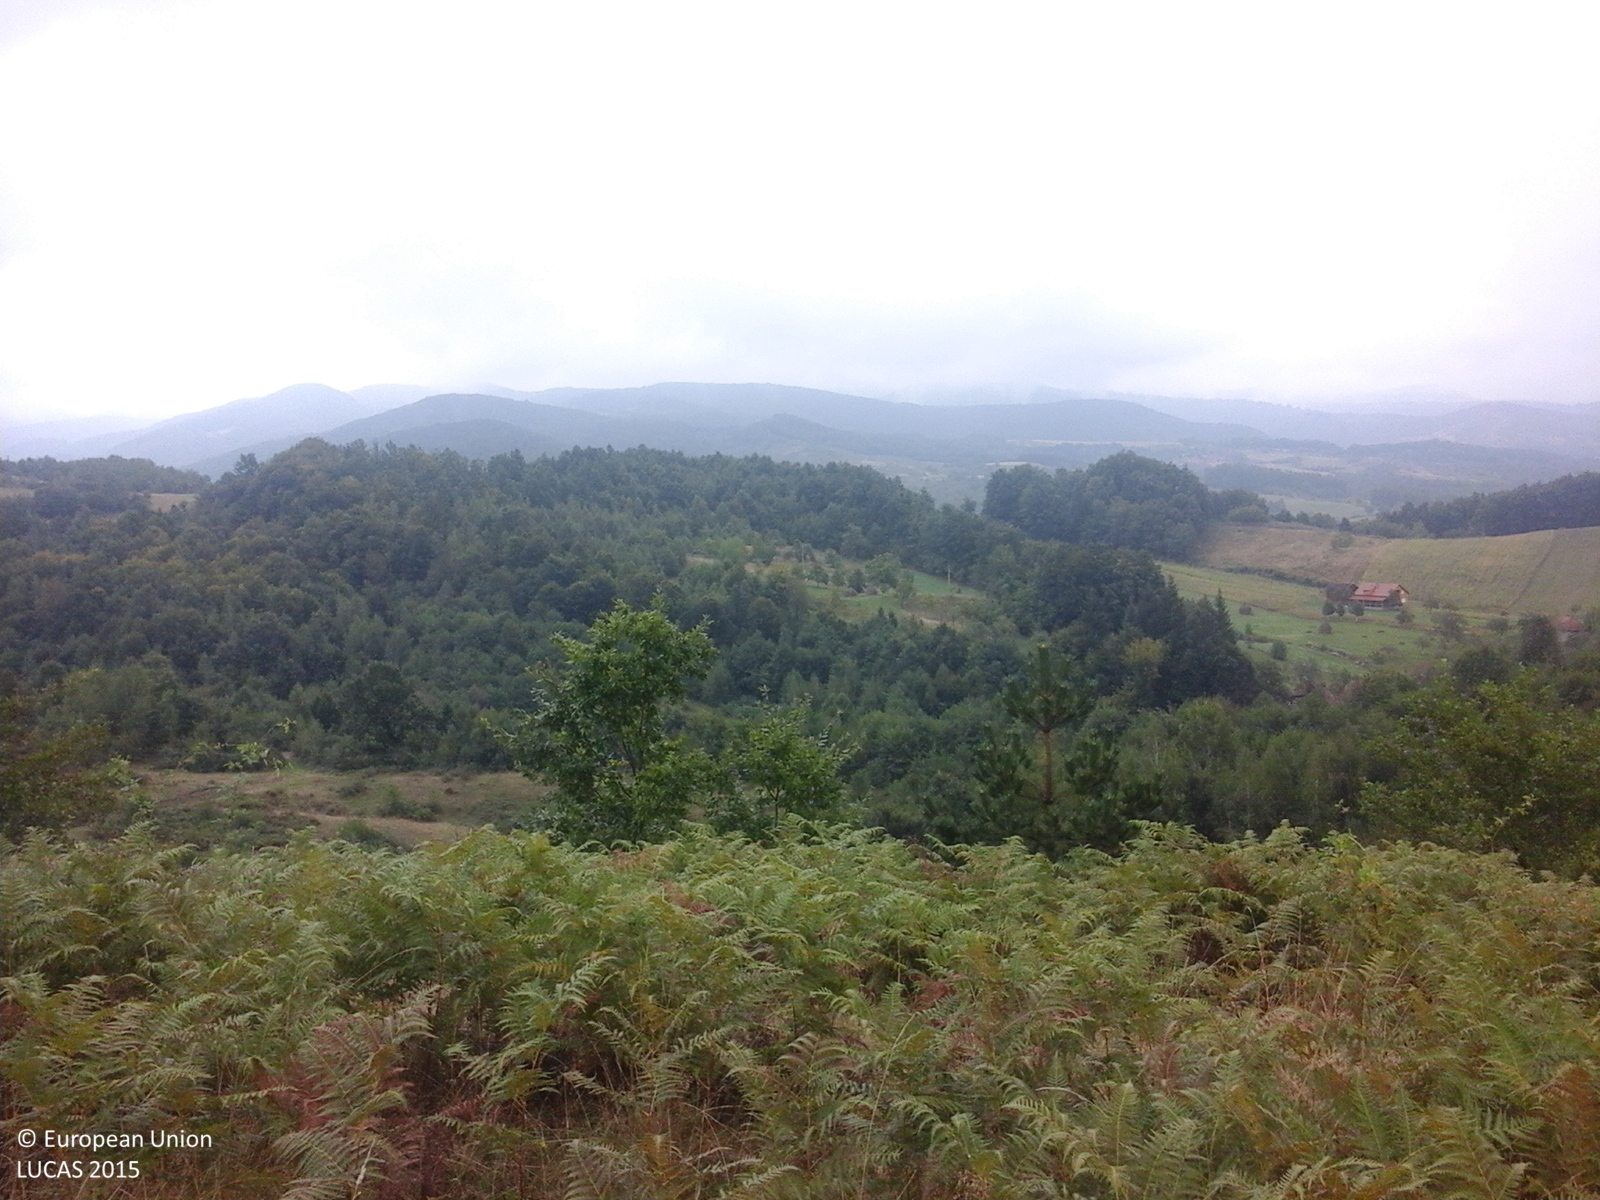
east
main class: Grassland
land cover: Spontaneously vegetated surfaces
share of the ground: > 75 %
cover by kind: herbaceous plants 100 %
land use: Fallow land
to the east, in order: Spontaneously vegetated surfaces; Grassland with sparse tree/shrub cover; Broadleaved woodland; Grassland with sparse tree/shrub cover; Broadleaved woodland
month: September
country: RO
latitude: 47.0035
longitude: 22.6163
